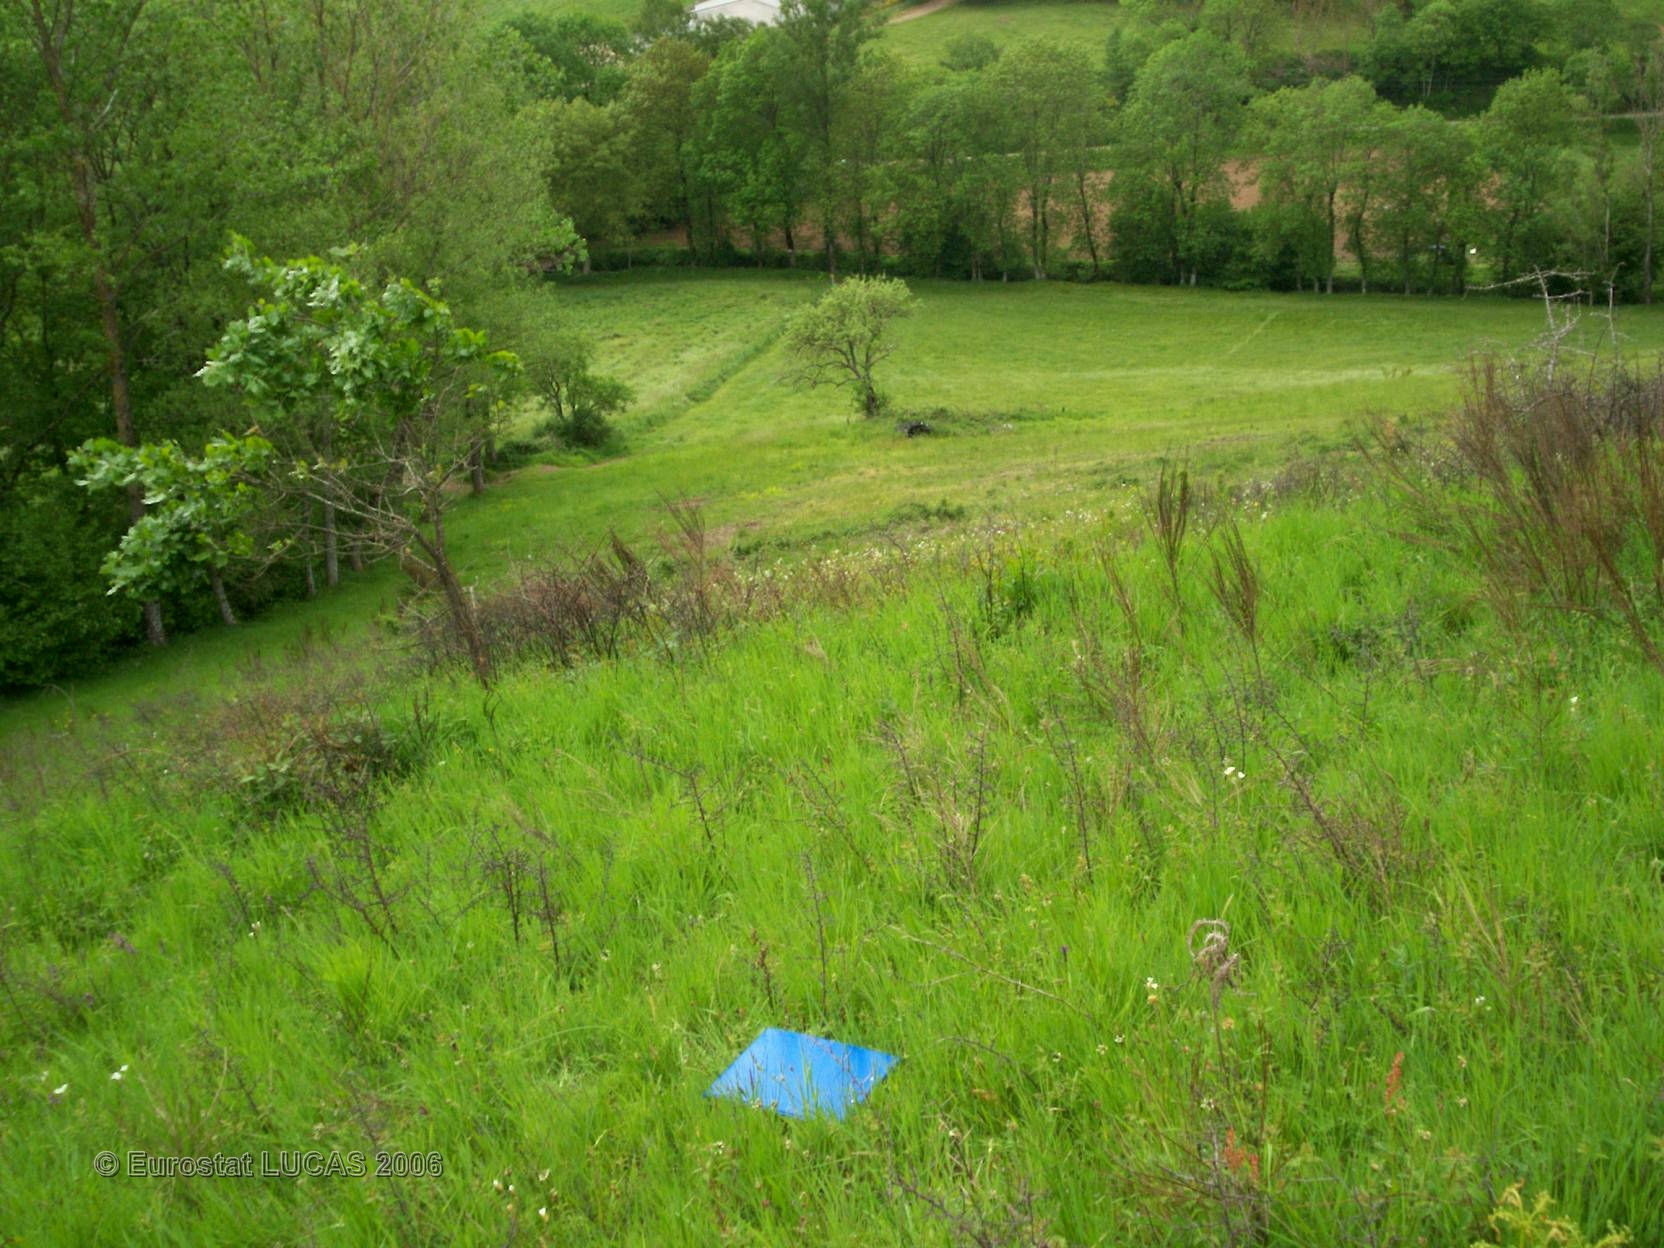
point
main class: Grassland
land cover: Grassland with sparse tree/shrub cover
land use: Agriculture (excluding fallow land and kitchen gardens)
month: May
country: FR
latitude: 43.9767
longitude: 3.3876
